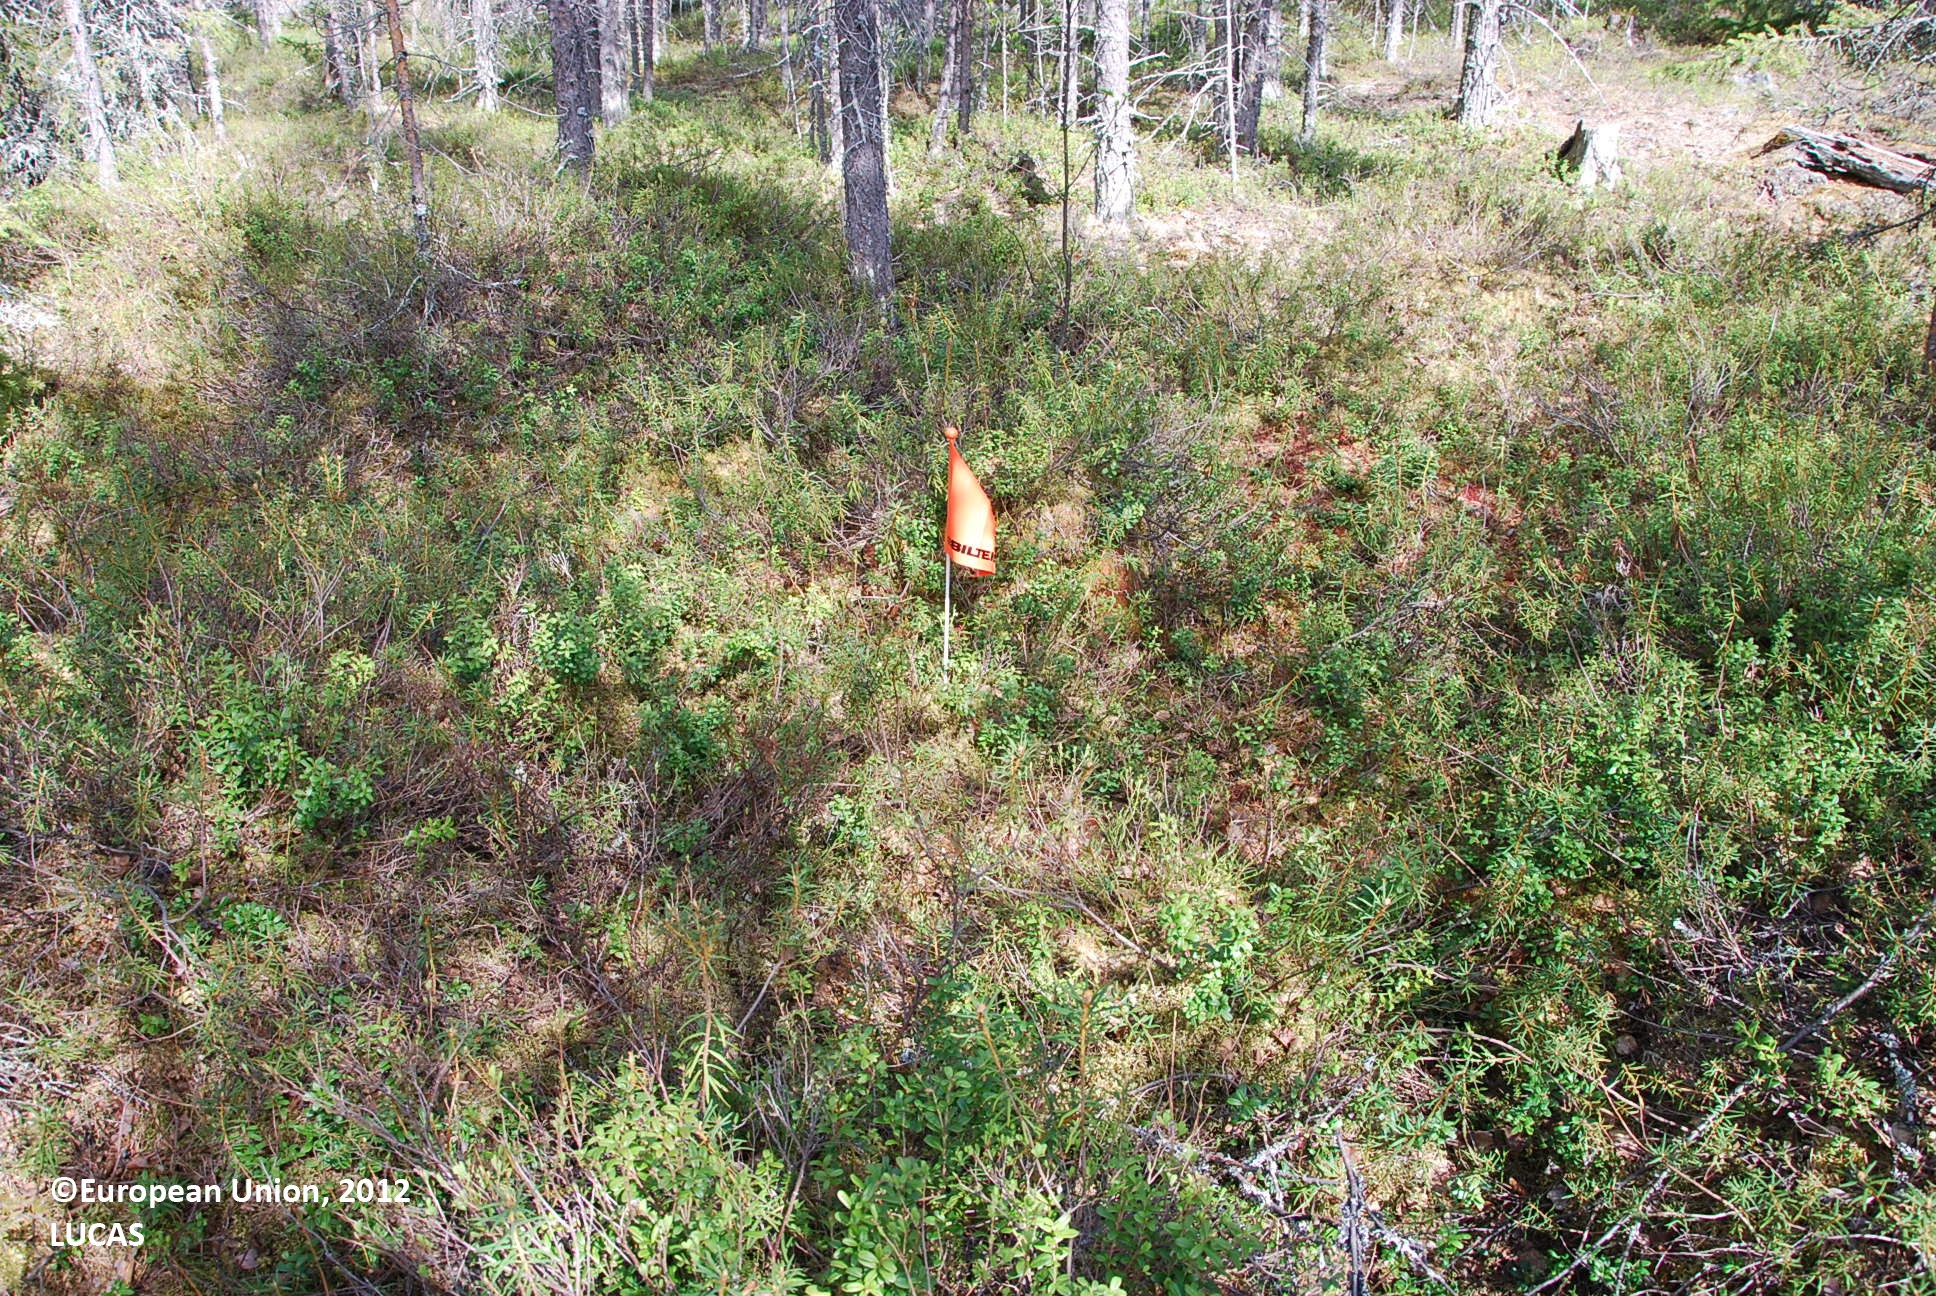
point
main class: Woodland
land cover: Pine dominated coniferous woodland
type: boreal forest
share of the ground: > 75 %
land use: Forestry
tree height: > 5 m
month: June
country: FI
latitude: 66.6011
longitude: 28.0230
